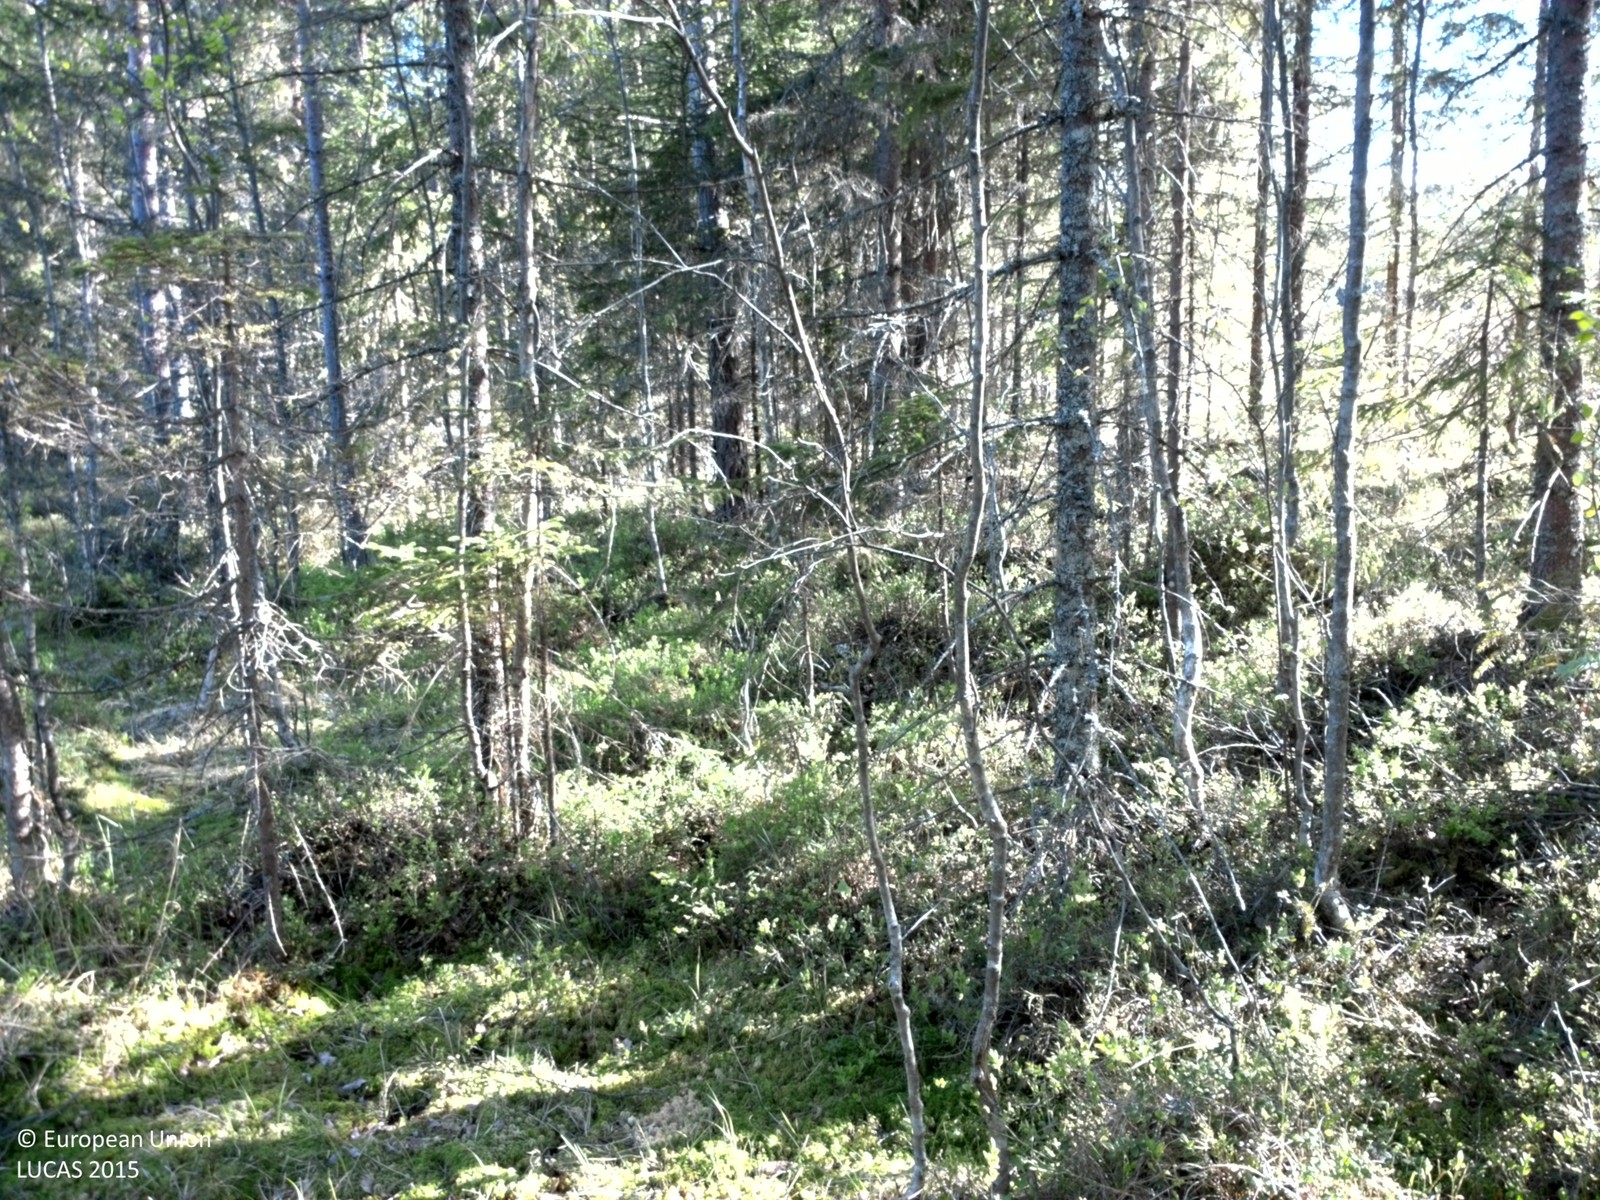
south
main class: Woodland
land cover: Spruce dominated coniferous woodland
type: boreal forest
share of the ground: > 75 %
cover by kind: coniferous forest trees 80 %, lichens and mosses 10 %, broadleaved forest trees 5 %, shrubs 5 %
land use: Forestry
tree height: > 5 m
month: May
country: SE
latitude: 59.4943
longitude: 12.3782
